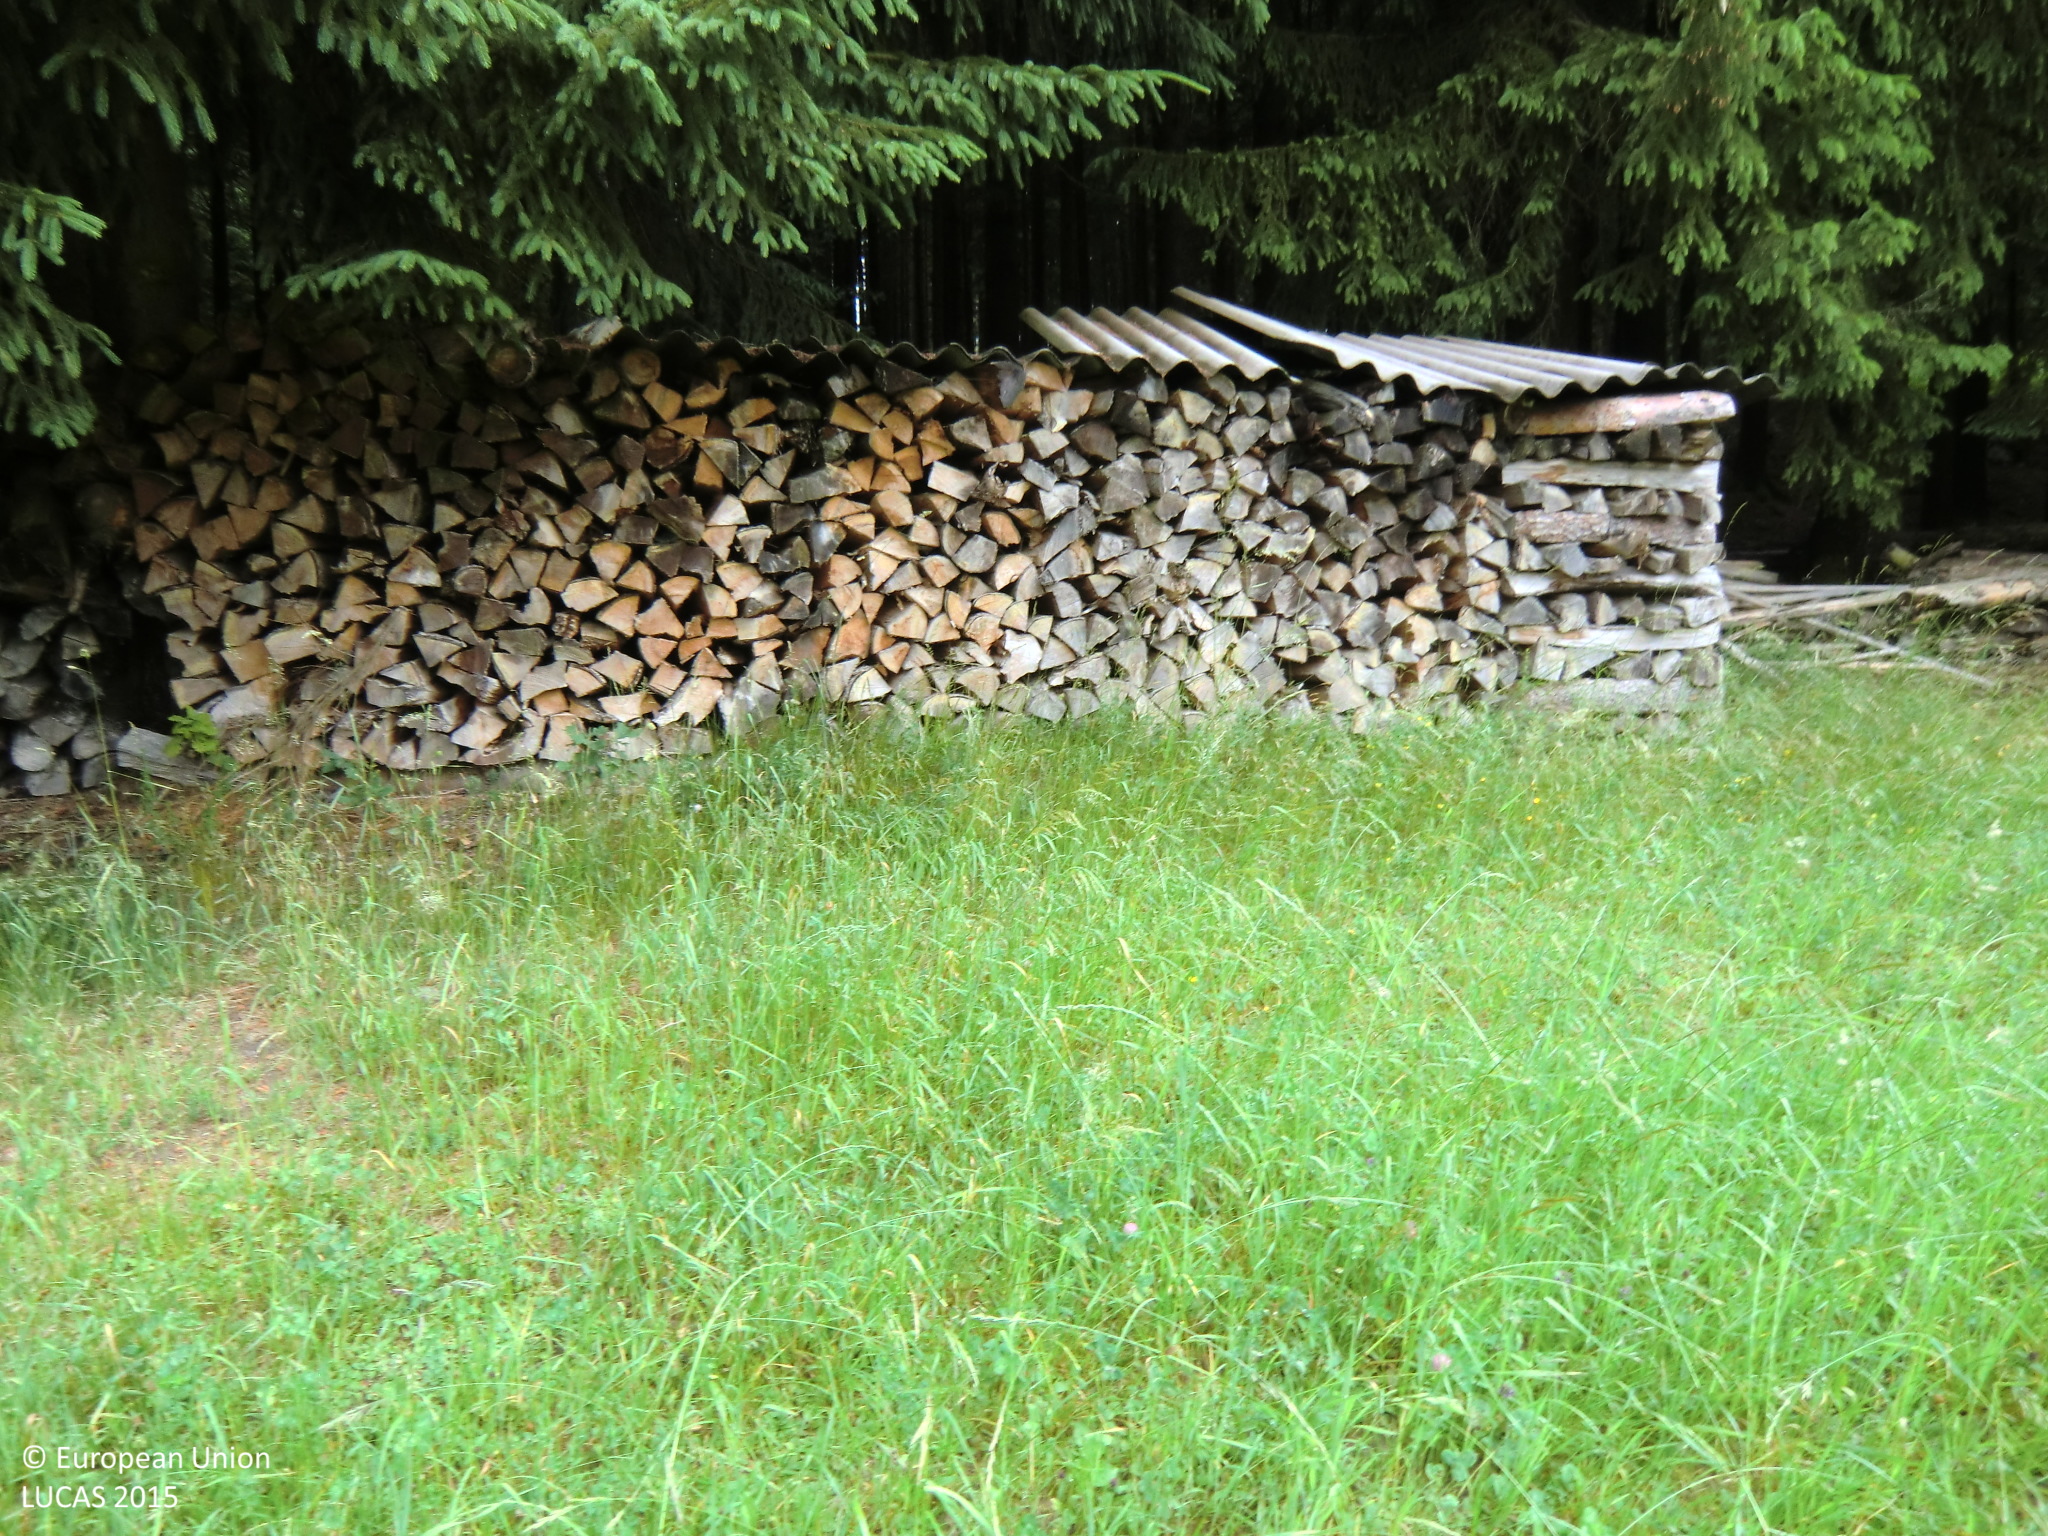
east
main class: Grassland
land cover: Grassland without tree/shrub cover
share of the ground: > 75 %
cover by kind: herbaceous plants 90 %, unconsolidated bare surface 10 %
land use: Agriculture (excluding fallow land and kitchen gardens)
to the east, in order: Grassland without tree/shrub cover; Spruce dominated coniferous woodland; Tracks; Spruce dominated coniferous woodland; Triticale; Grass margins; Barley; Grass margins; Maize
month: June
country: AT
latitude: 48.5076
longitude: 14.5623
